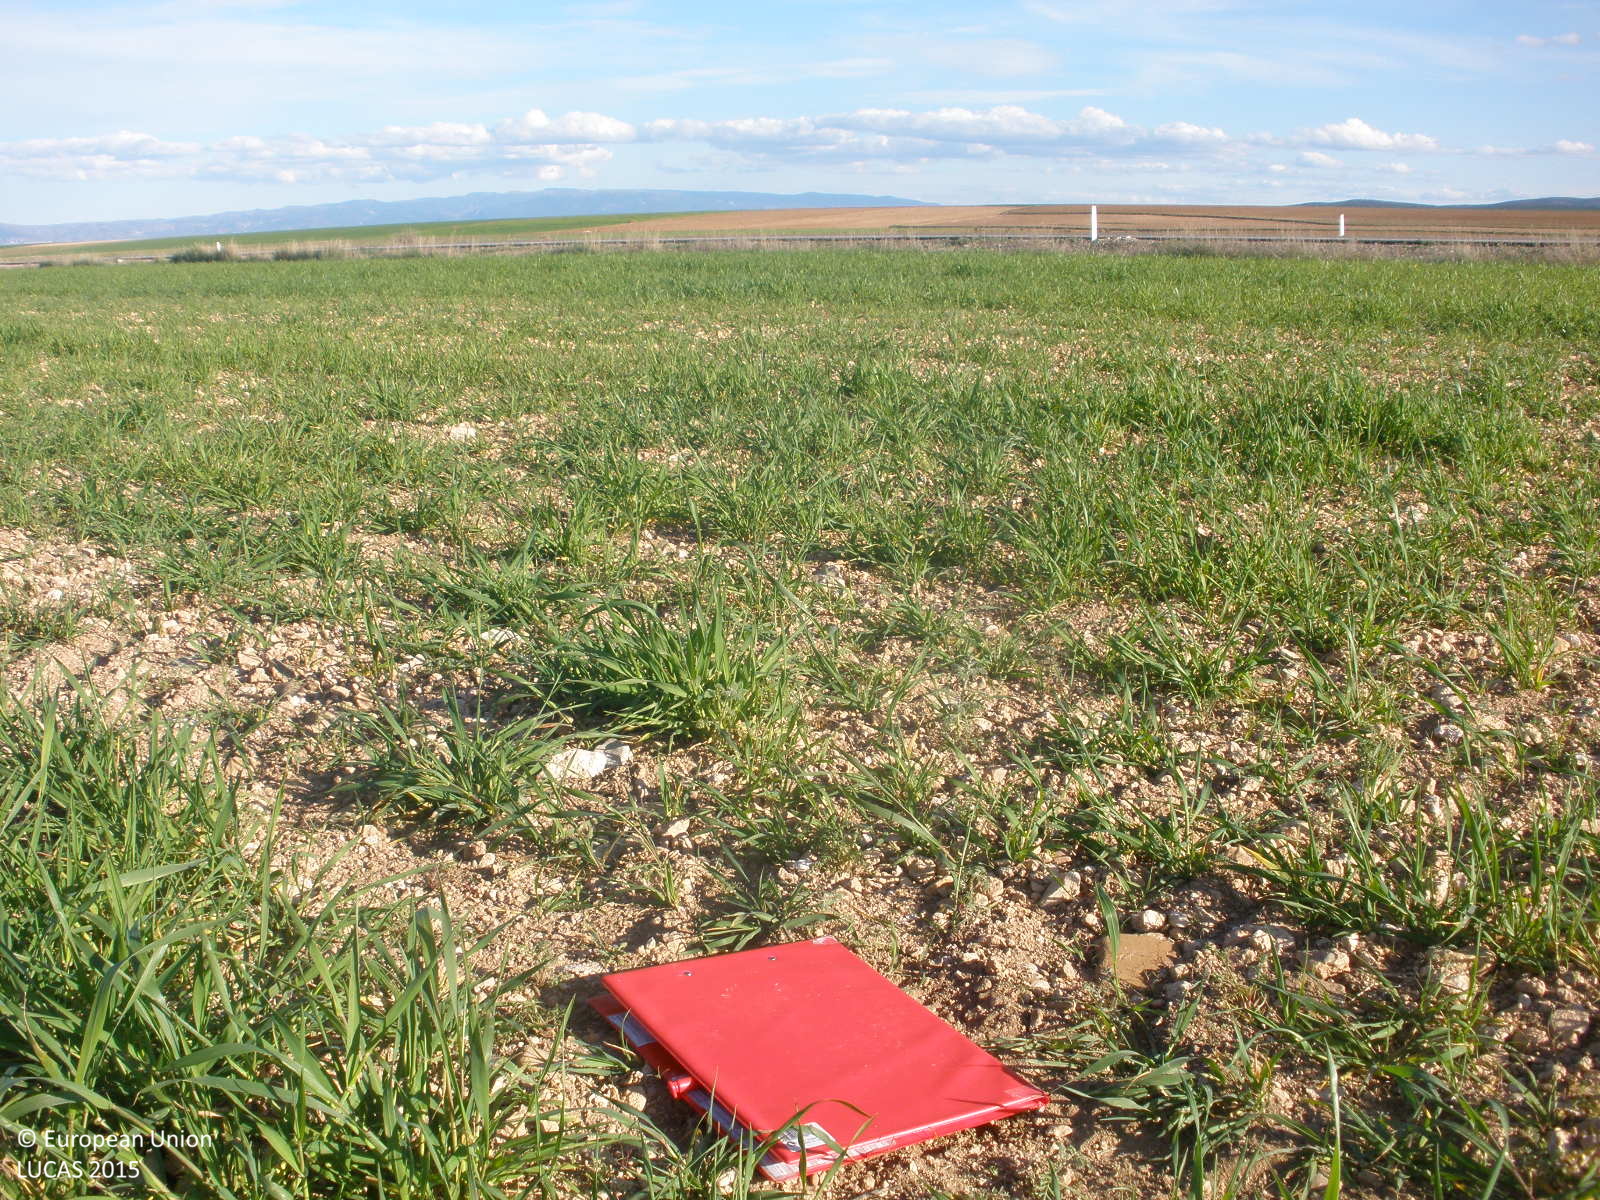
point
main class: Cropland
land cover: Barley
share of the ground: 50 - 75 %
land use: Agriculture (excluding fallow land and kitchen gardens)
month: April
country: ES
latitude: 40.4163
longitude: -1.2911
